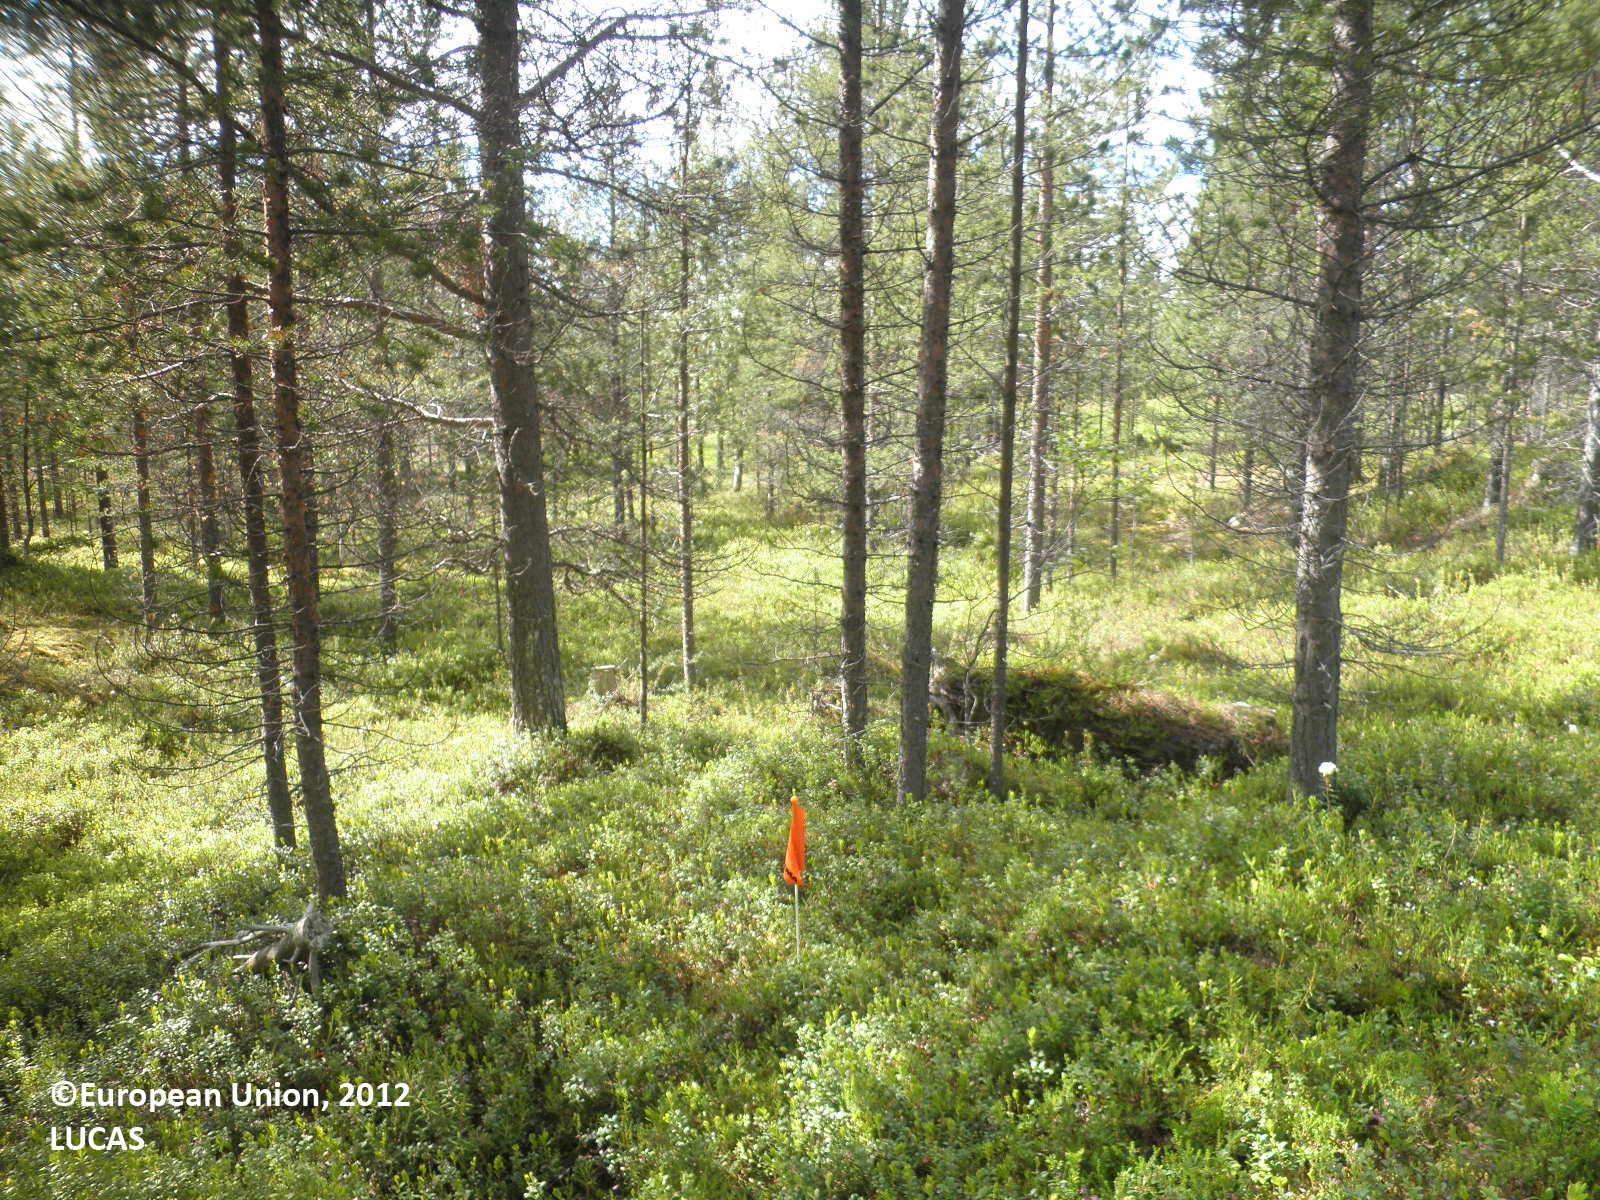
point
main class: Woodland
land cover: Pine dominated coniferous woodland
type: boreal forest
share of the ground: 50 - 75 %
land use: Forestry
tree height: > 5 m
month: July
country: FI
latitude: 68.7580
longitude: 28.0208
